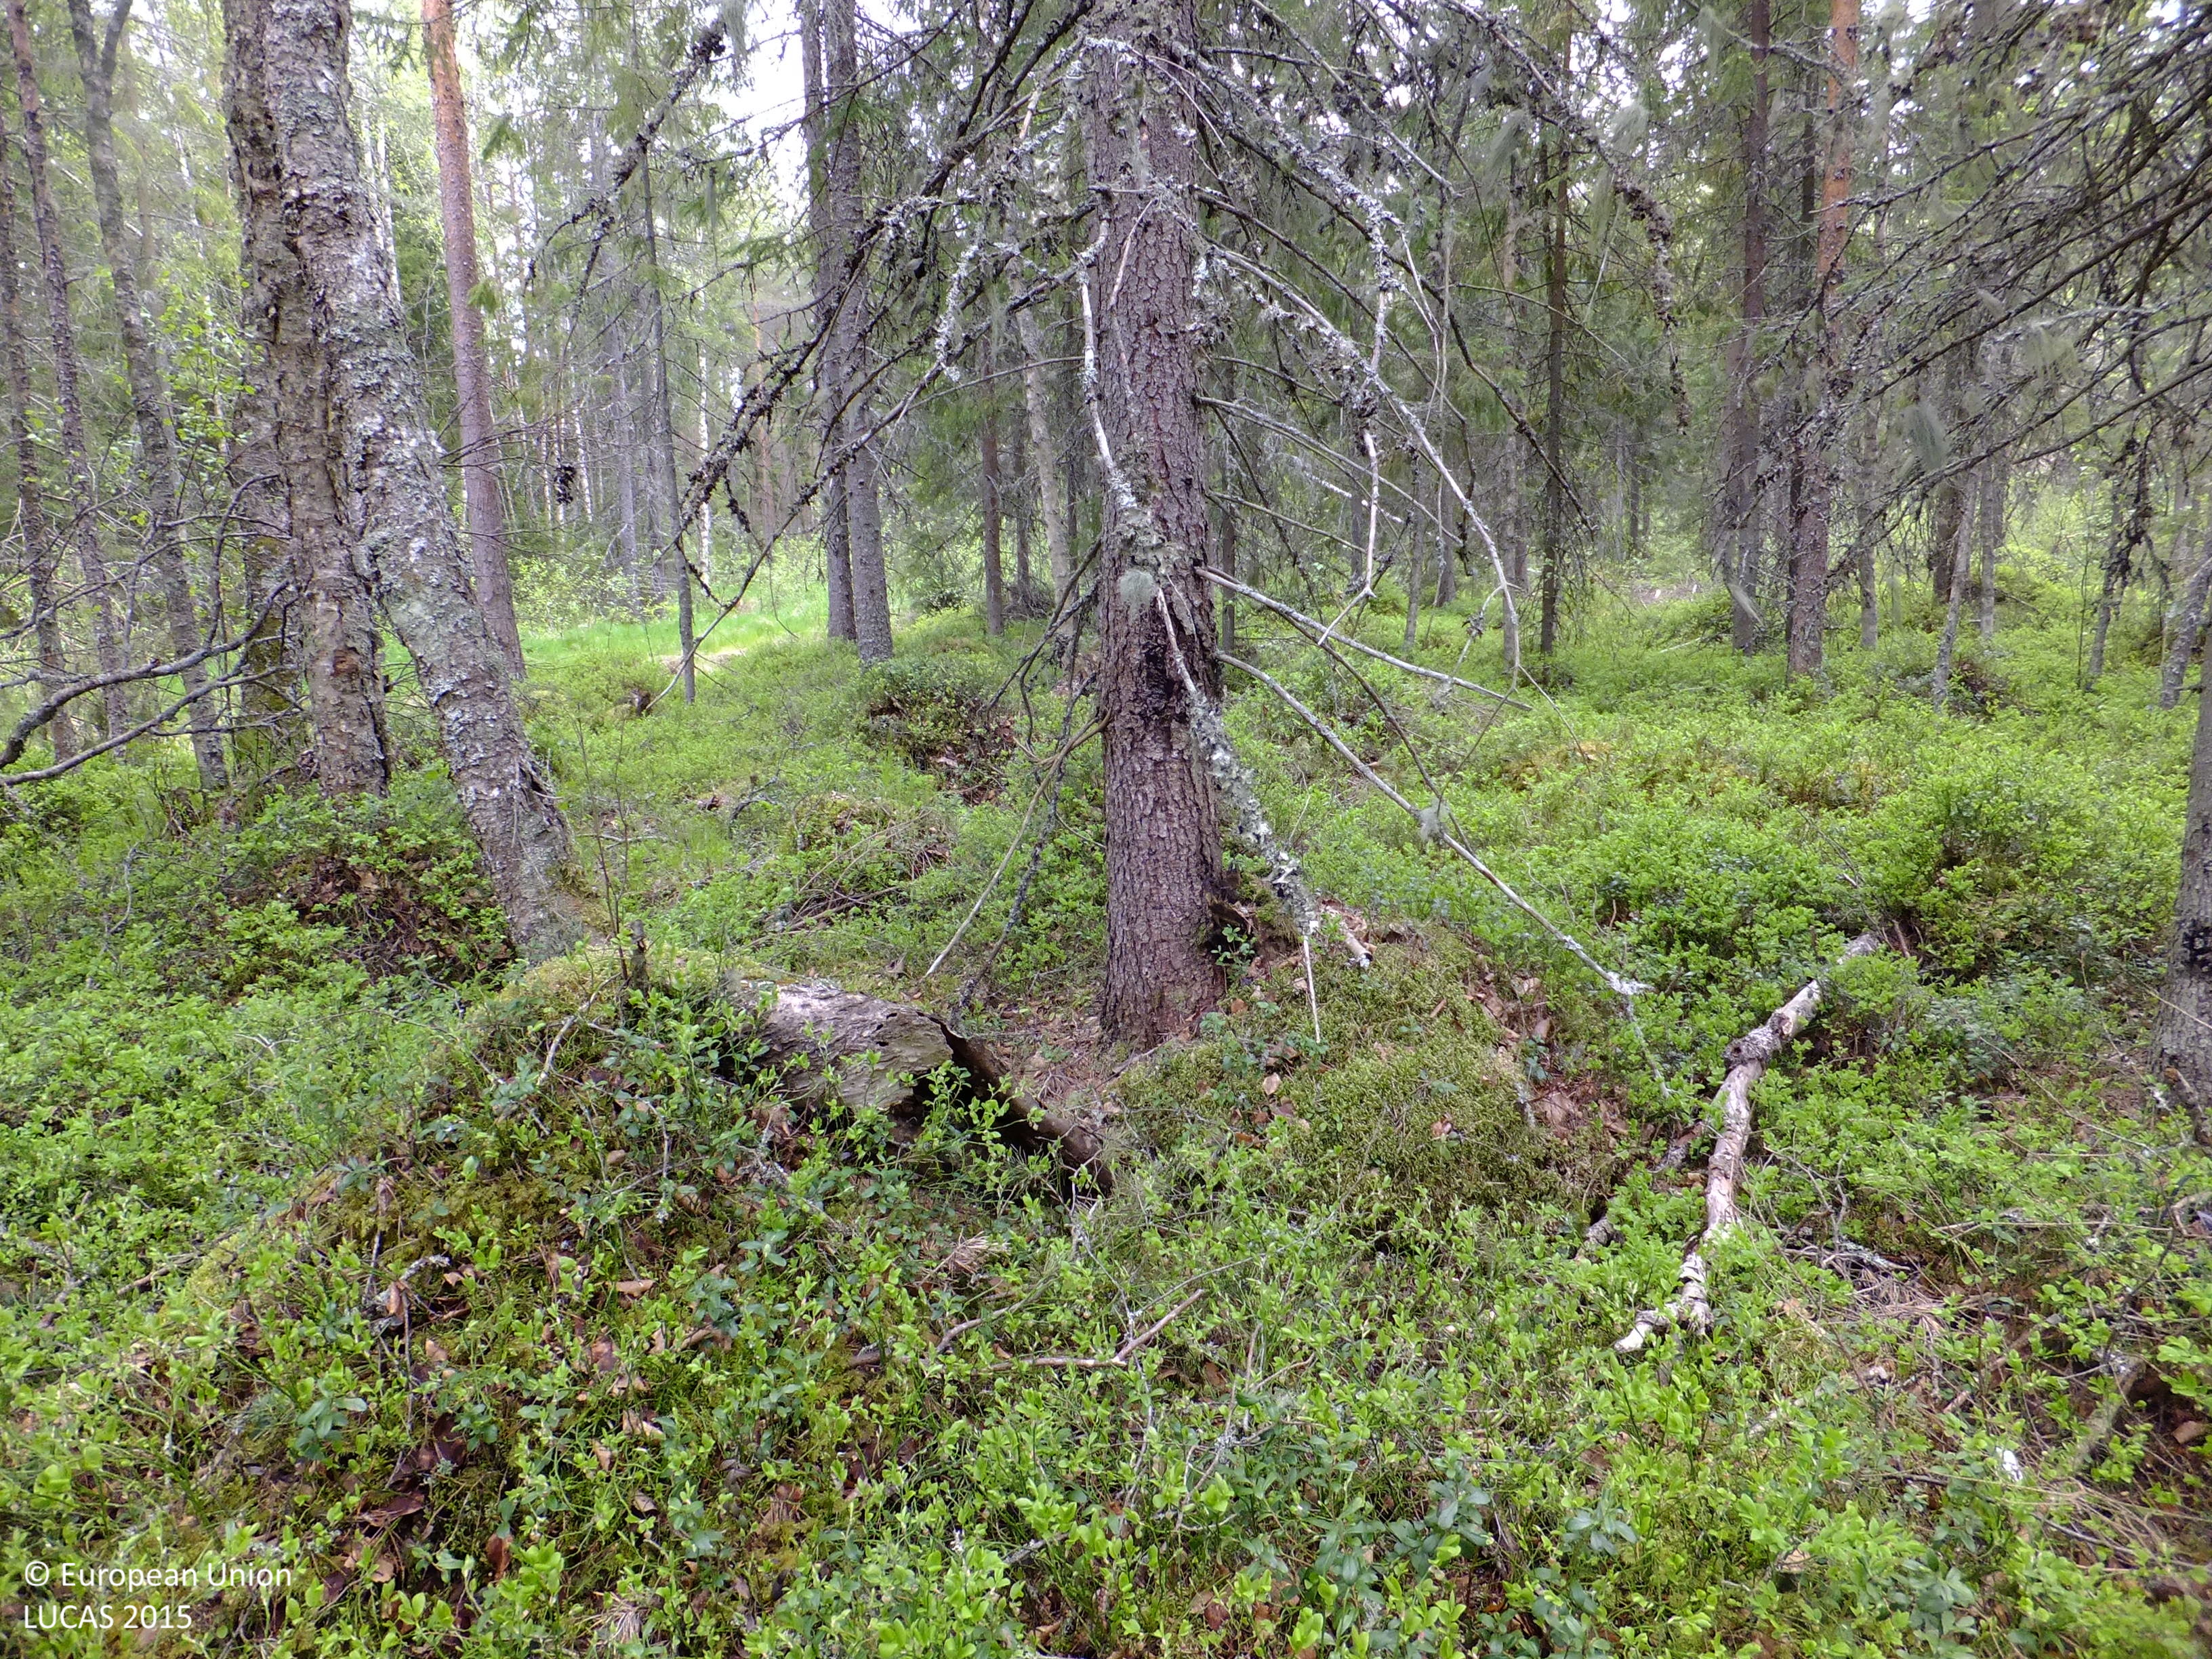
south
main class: Woodland
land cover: Spruce dominated mixed woodland
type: boreal forest
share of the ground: > 75 %
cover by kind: coniferous forest trees 50 %, broadleaved forest trees 30 %, shrubs 20 %
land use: Forestry
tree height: > 5 m
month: May
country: FI
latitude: 63.6112
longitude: 22.6930
